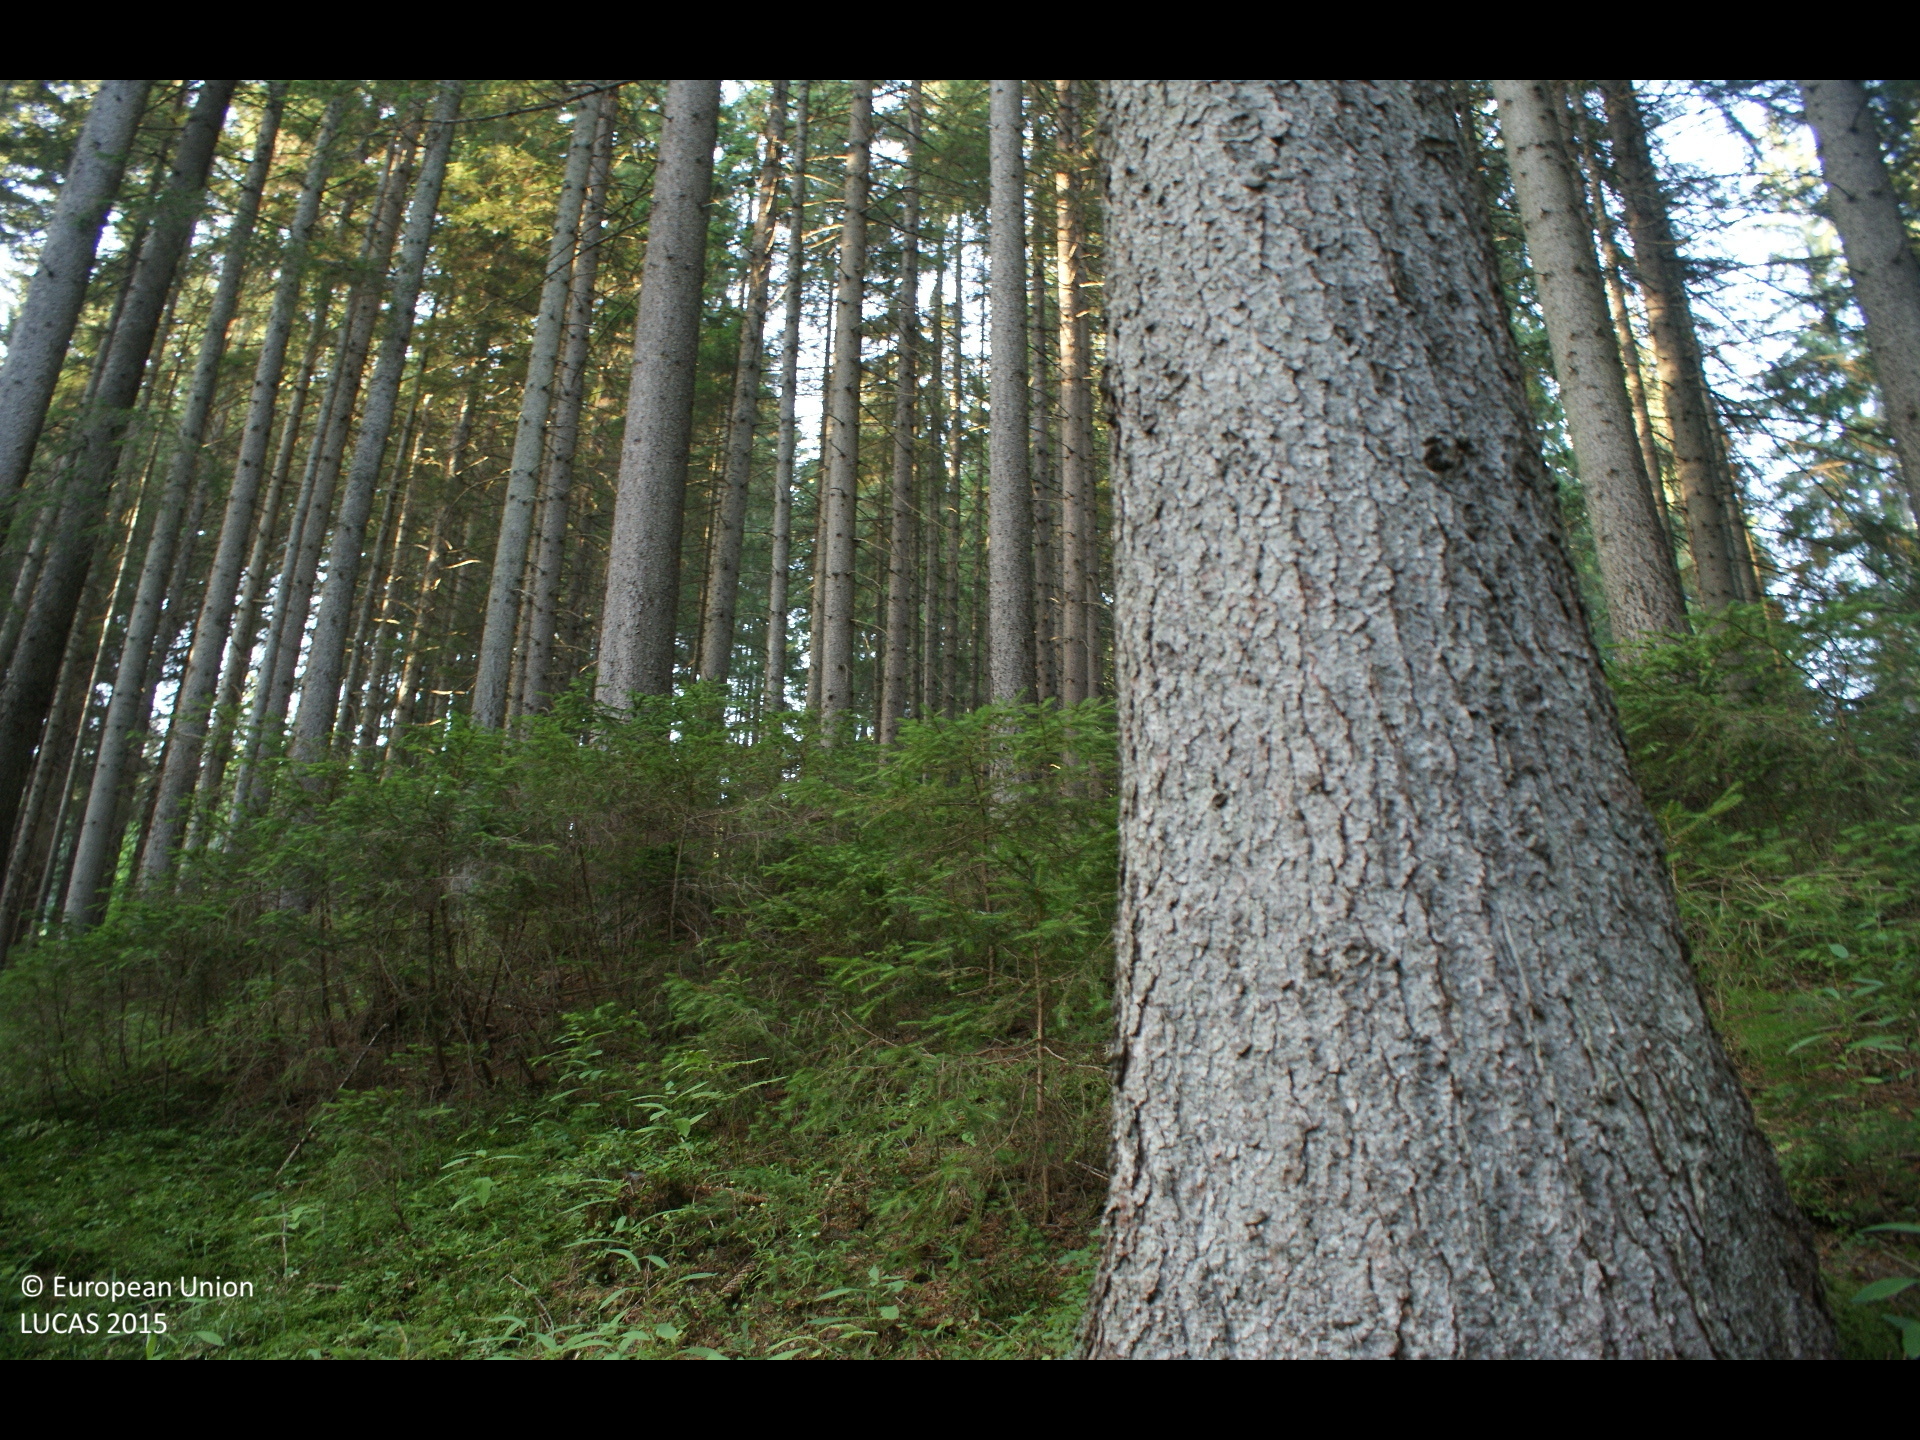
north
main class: Woodland
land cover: Spruce dominated coniferous woodland
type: alpine coniferous forest
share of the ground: > 75 %
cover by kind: coniferous forest trees 85 %, shrubs 5 %, herbaceous plants 5 %, lichens and mosses 5 %
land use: Forestry
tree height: > 5 m
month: July
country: AT
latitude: 47.7663
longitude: 15.4050
